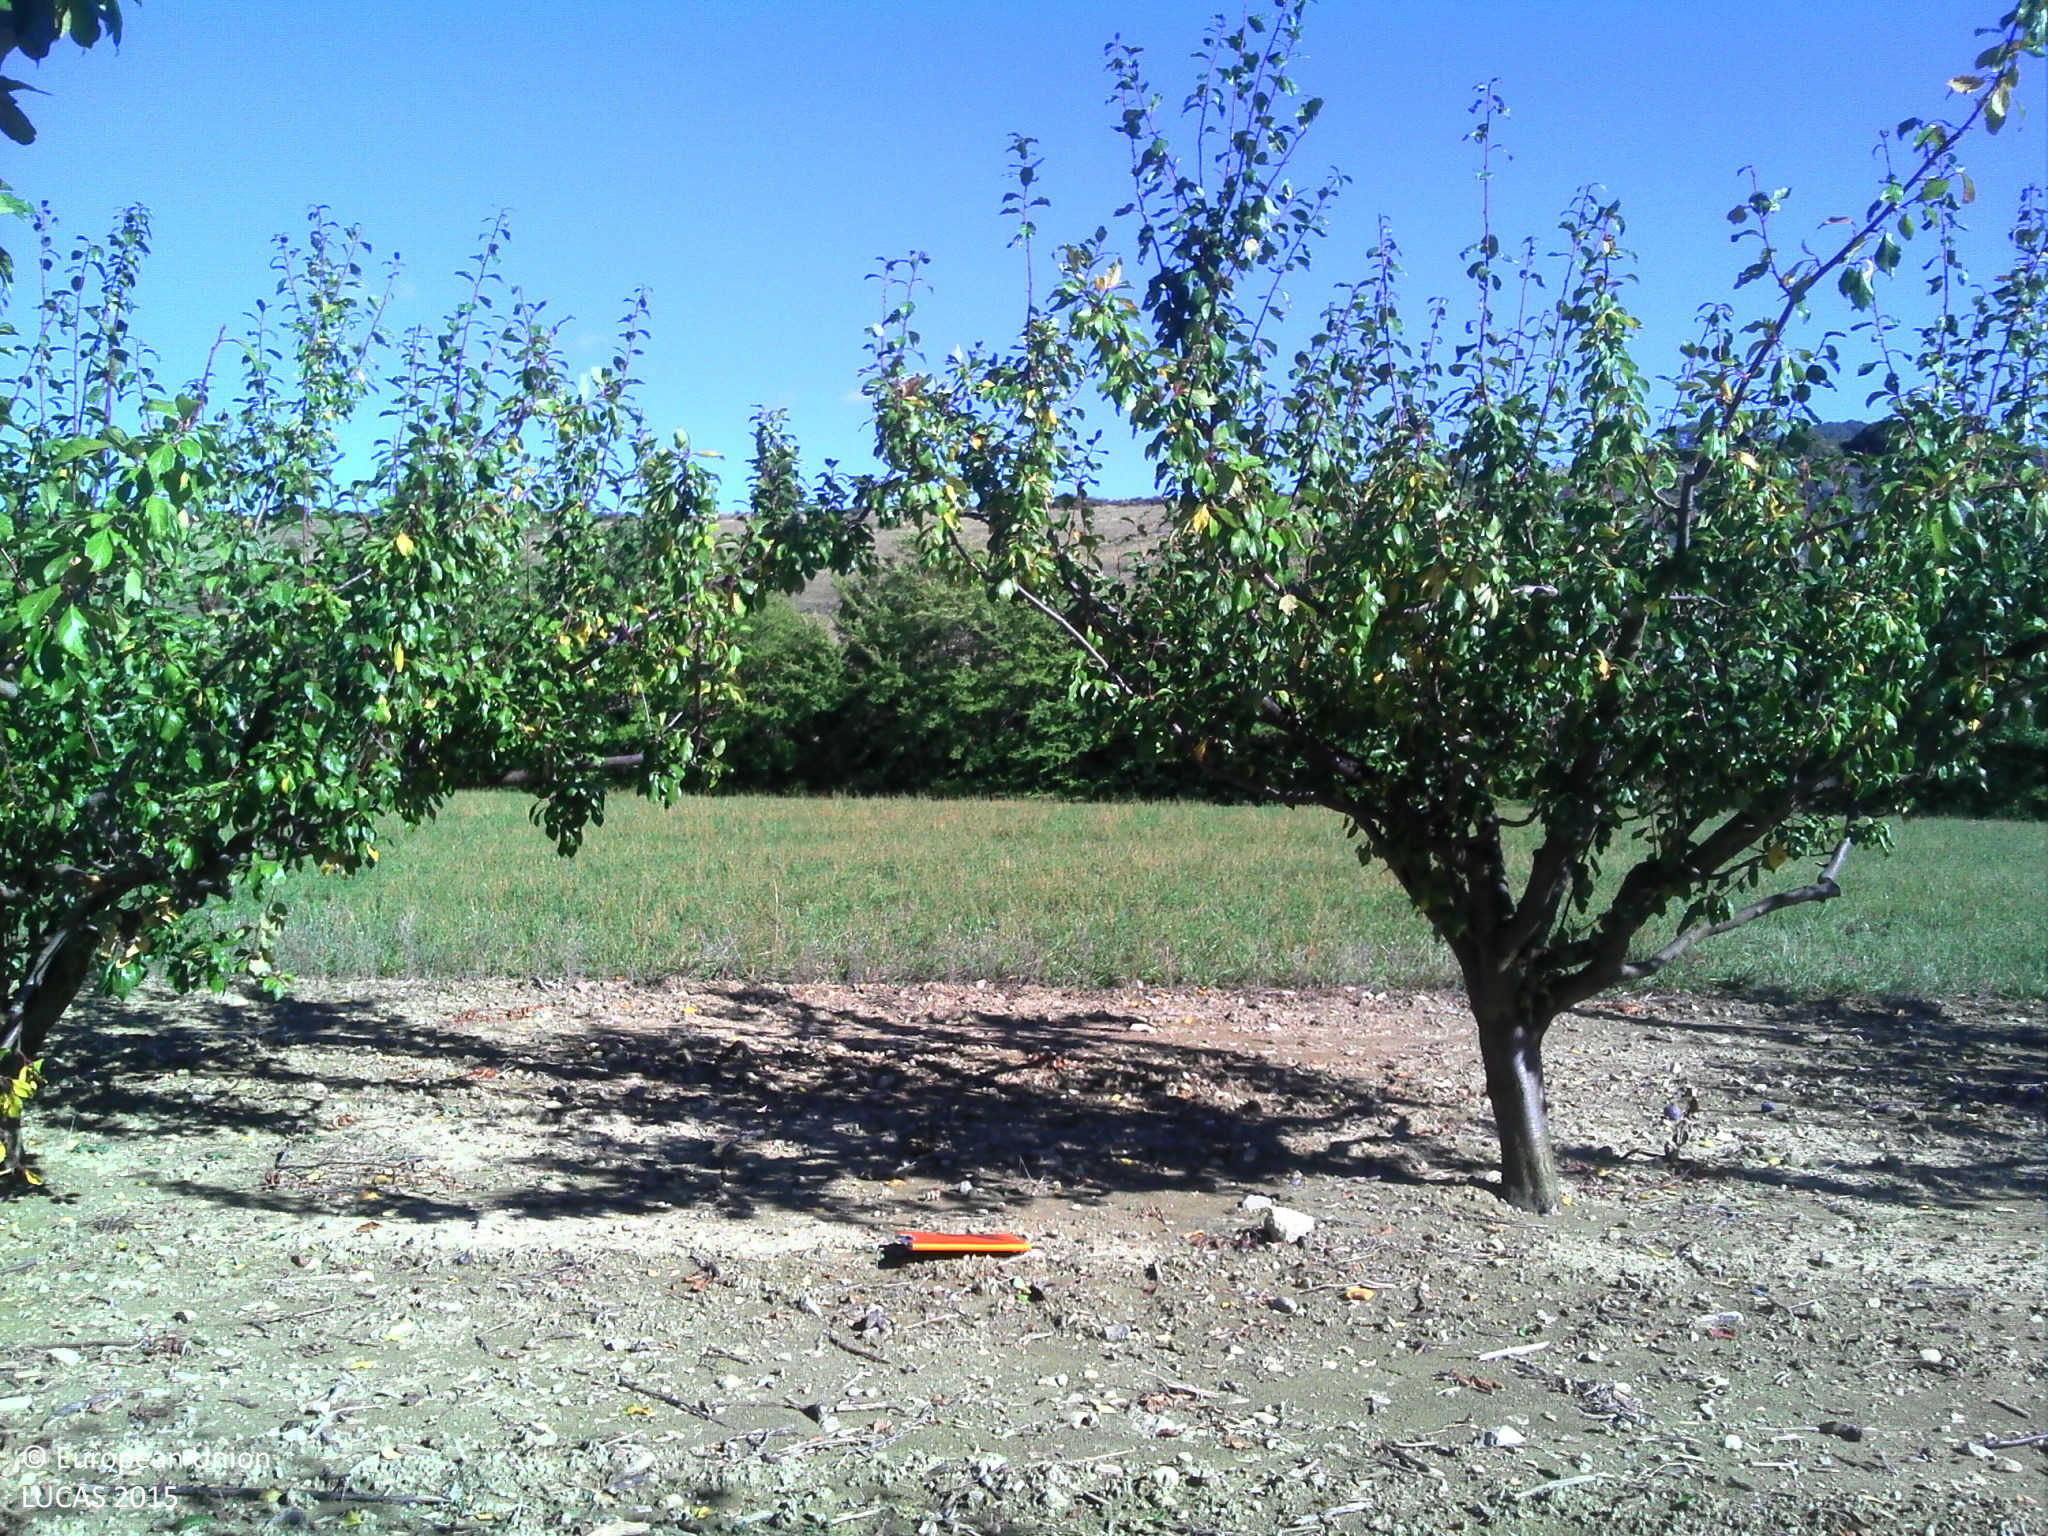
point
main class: Cropland
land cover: Other fruit trees and berries
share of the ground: > 75 %
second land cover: Other bare soil
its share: > 75 %
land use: Agriculture (excluding fallow land and kitchen gardens)
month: September
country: FR
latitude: 44.3357
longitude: 5.3294
